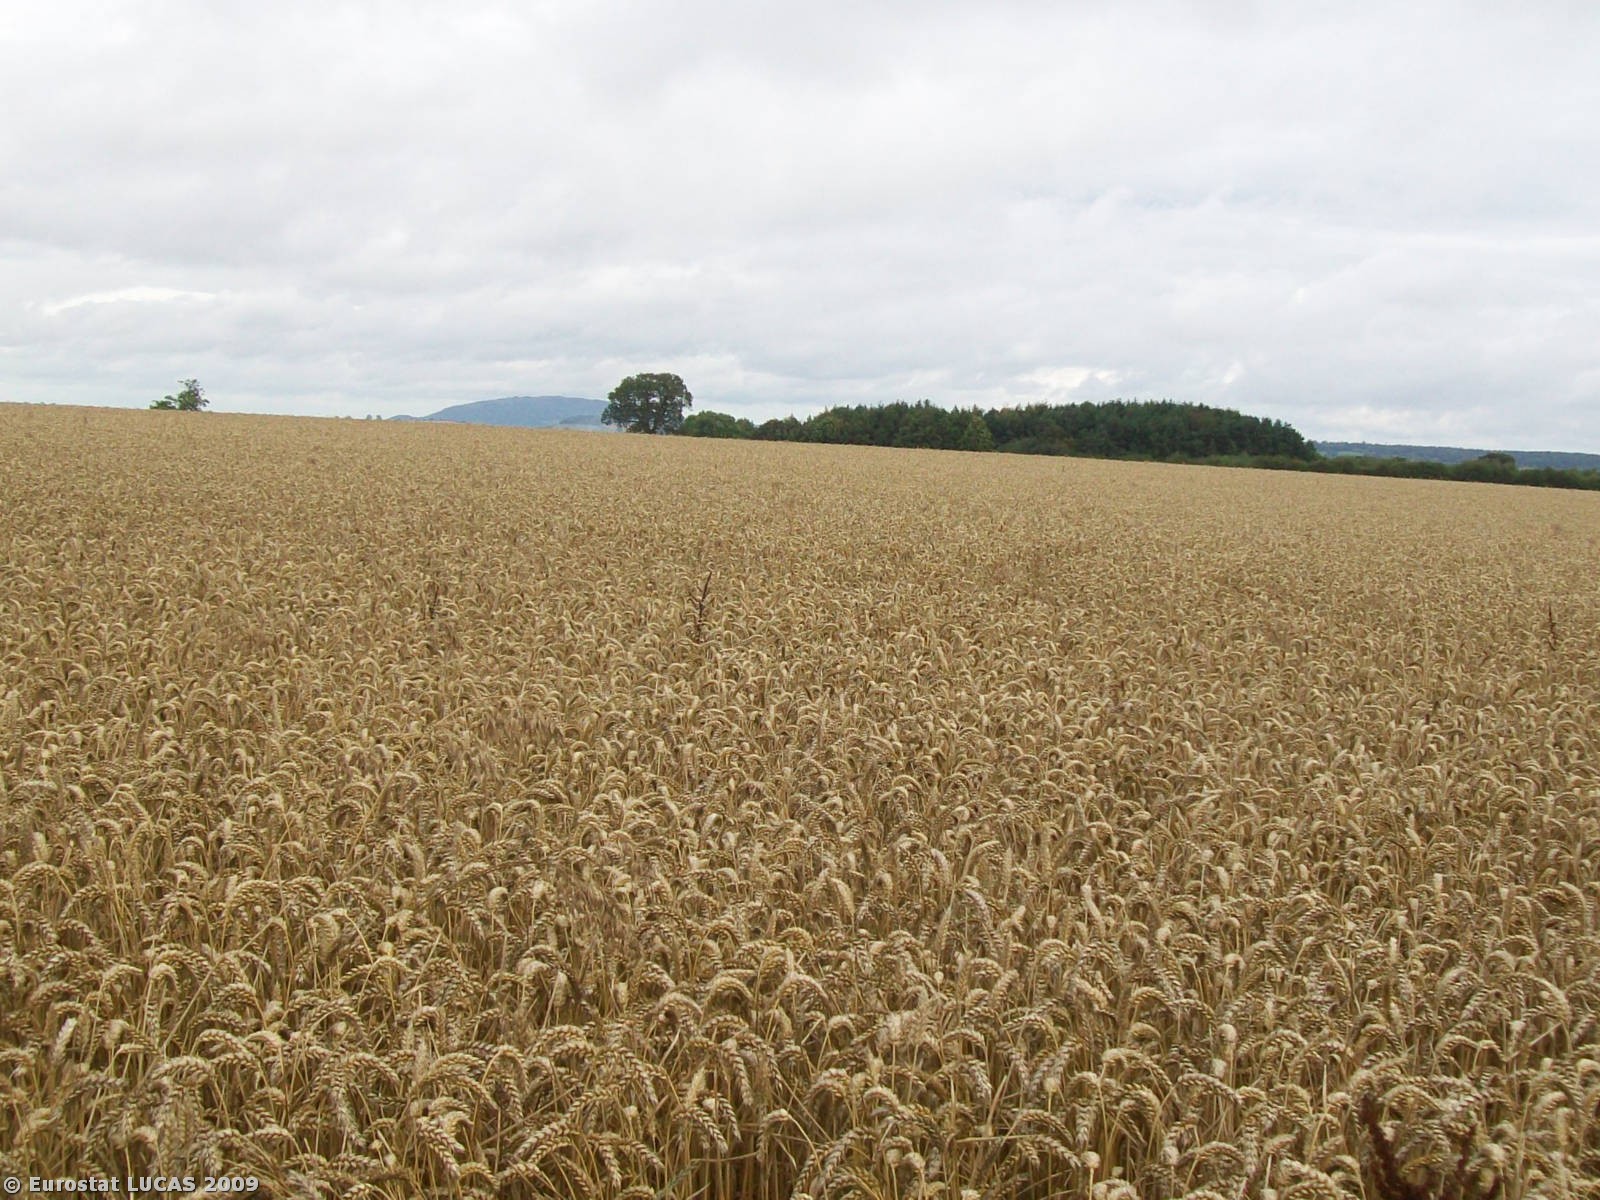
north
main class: Cropland
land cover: Common wheat
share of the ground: > 75 %
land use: Agriculture (excluding fallow land and kitchen gardens)
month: September
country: GB
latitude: 52.5302
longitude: -2.5227
